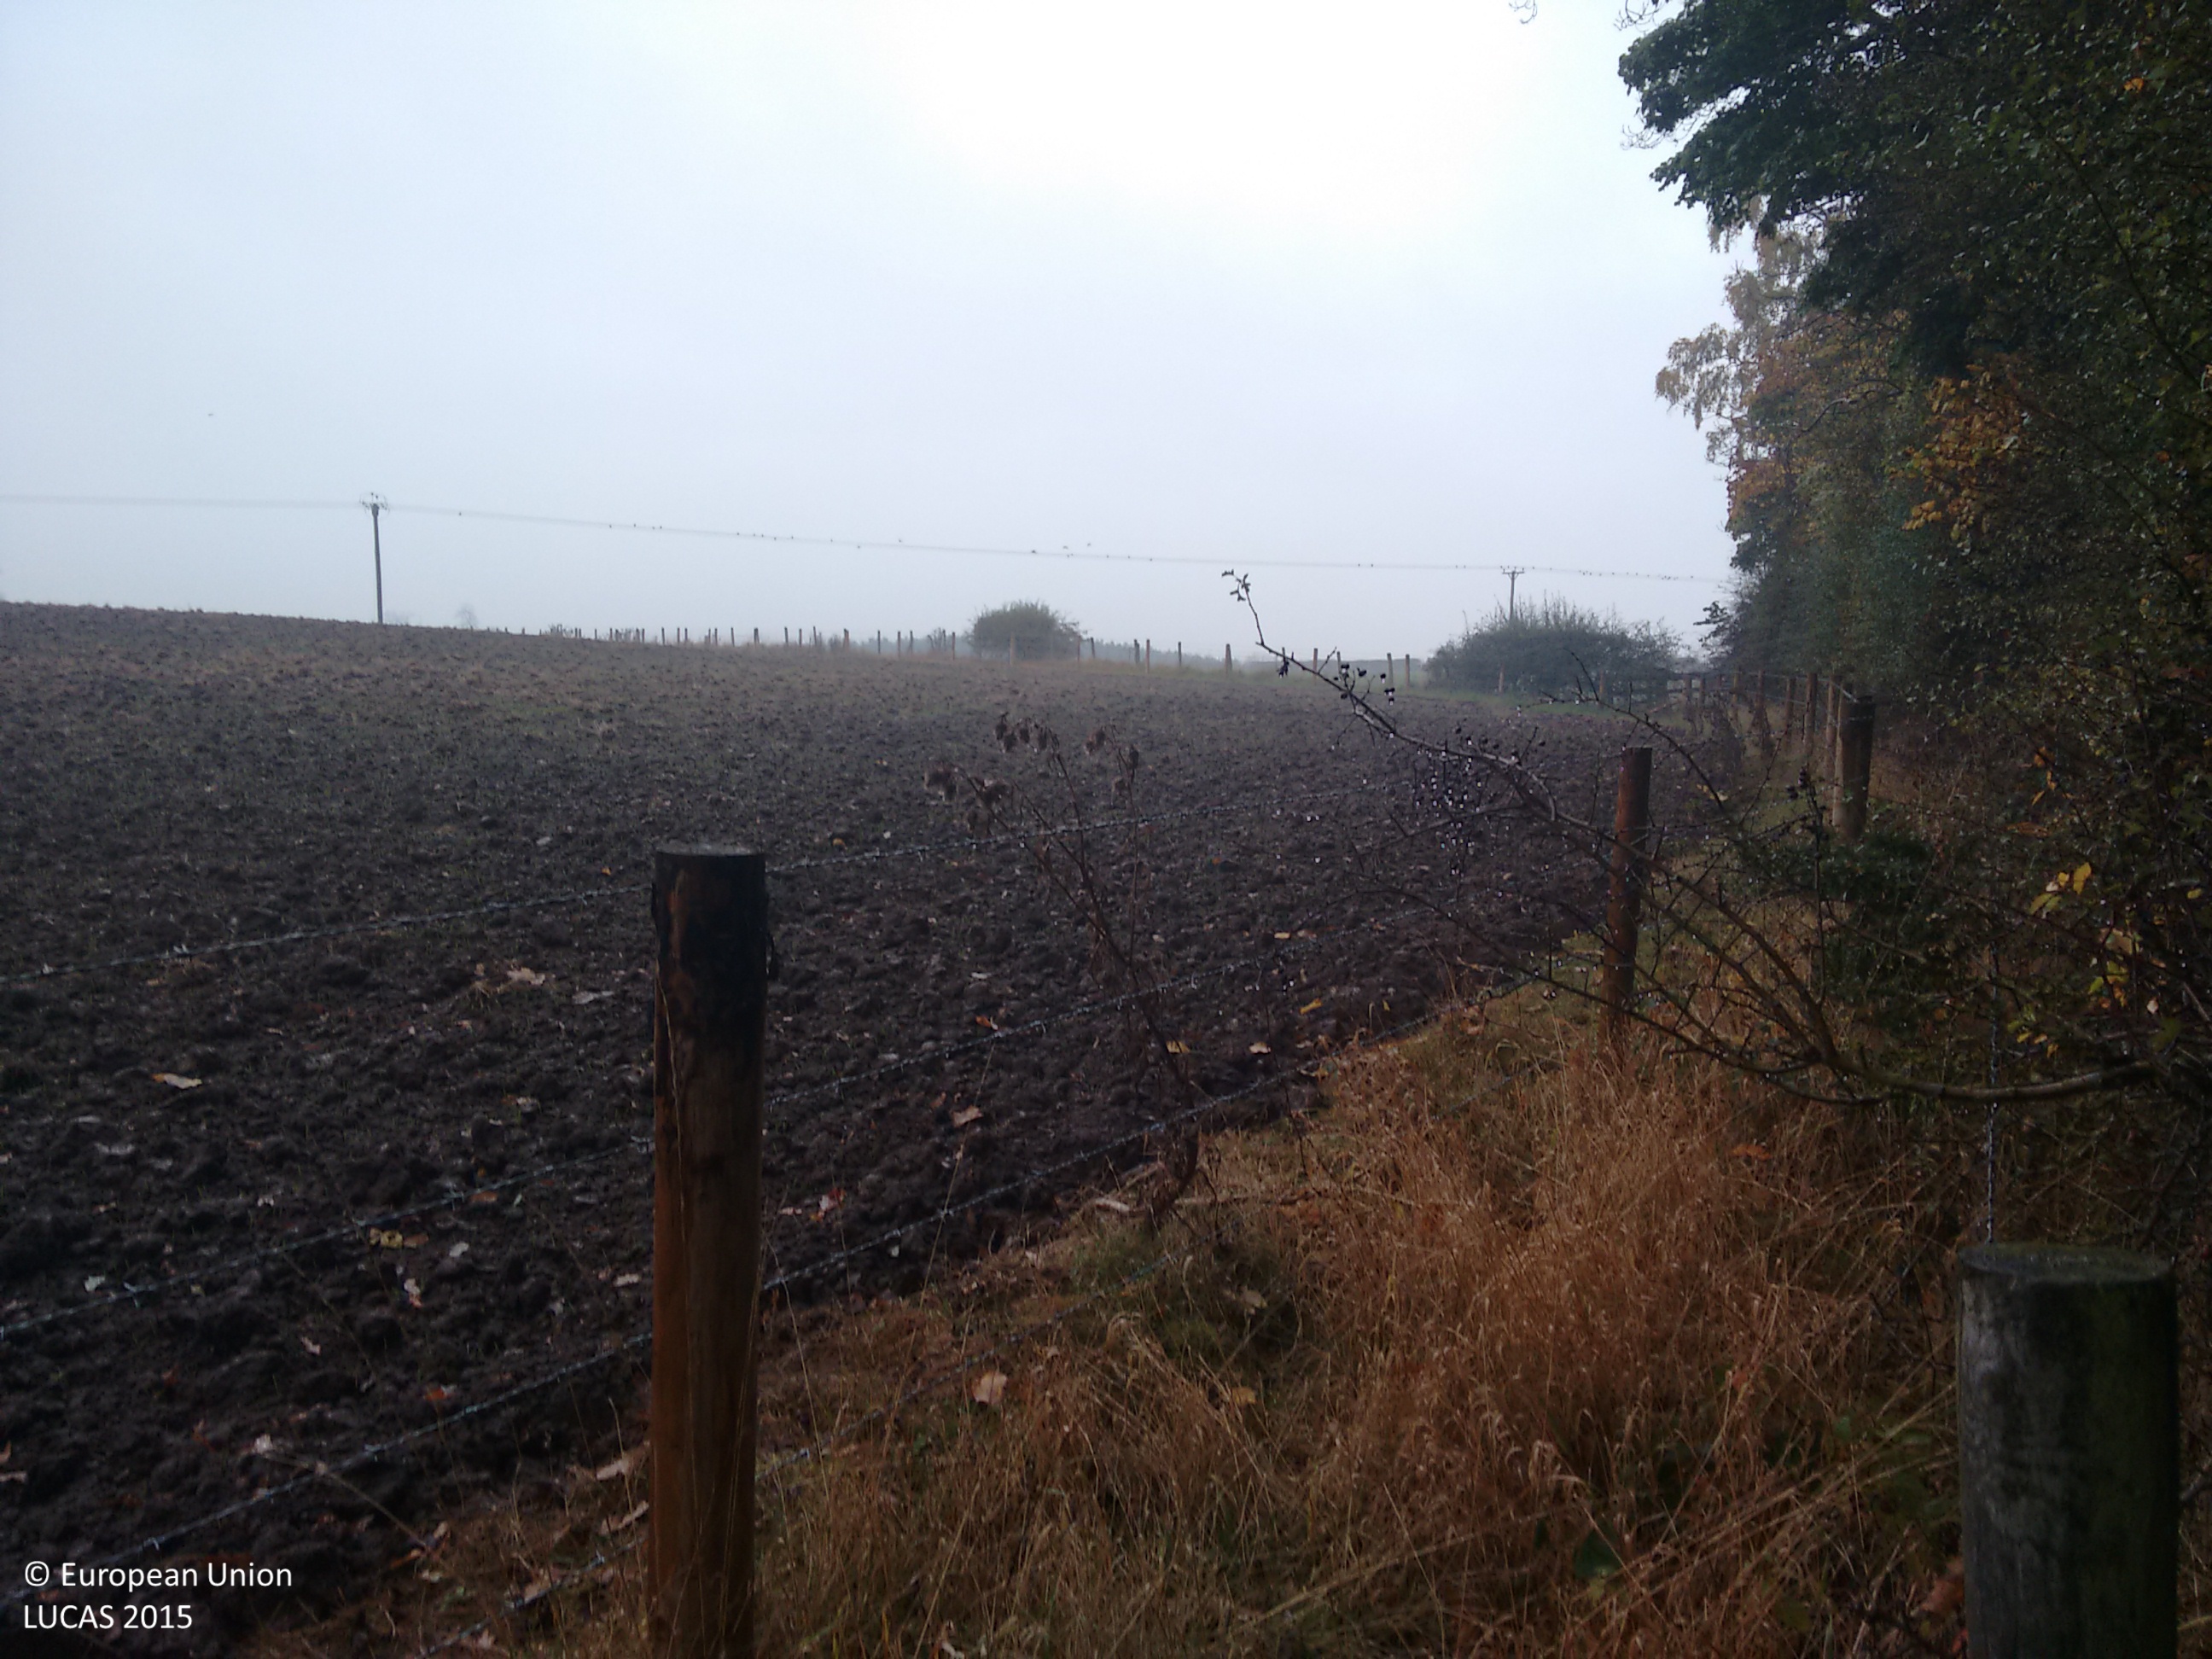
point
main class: Cropland
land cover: Common wheat
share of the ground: < 10 %
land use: Agriculture (excluding fallow land and kitchen gardens)
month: October
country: GB
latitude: 54.5324
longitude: -1.4055
